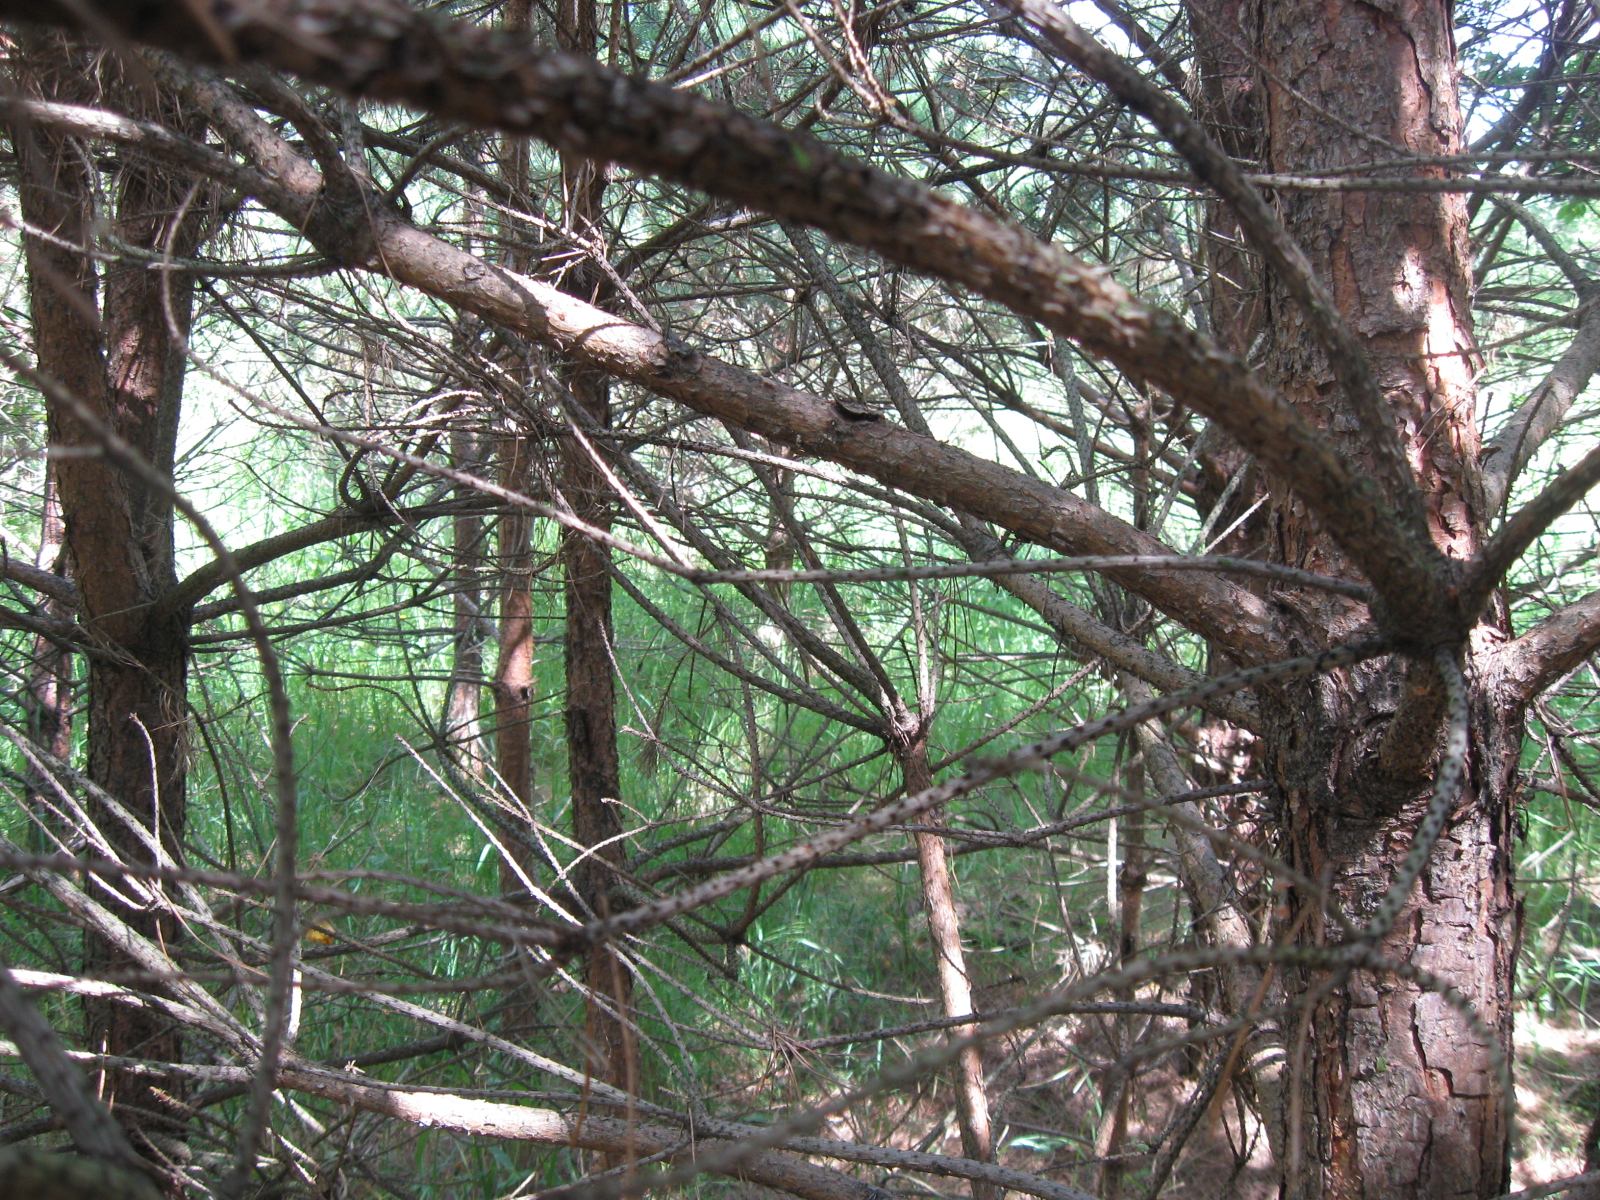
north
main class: Woodland
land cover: Pine dominated coniferous woodland
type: hemiboreal forest and nemoral coniferous forest and mixed broadleaved-coniferous forest
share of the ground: > 75 %
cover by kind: coniferous forest trees 95 %, herbaceous plants 5 %
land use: Forestry
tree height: < 5 m
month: July
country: LT
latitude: 54.3632
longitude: 24.5558
